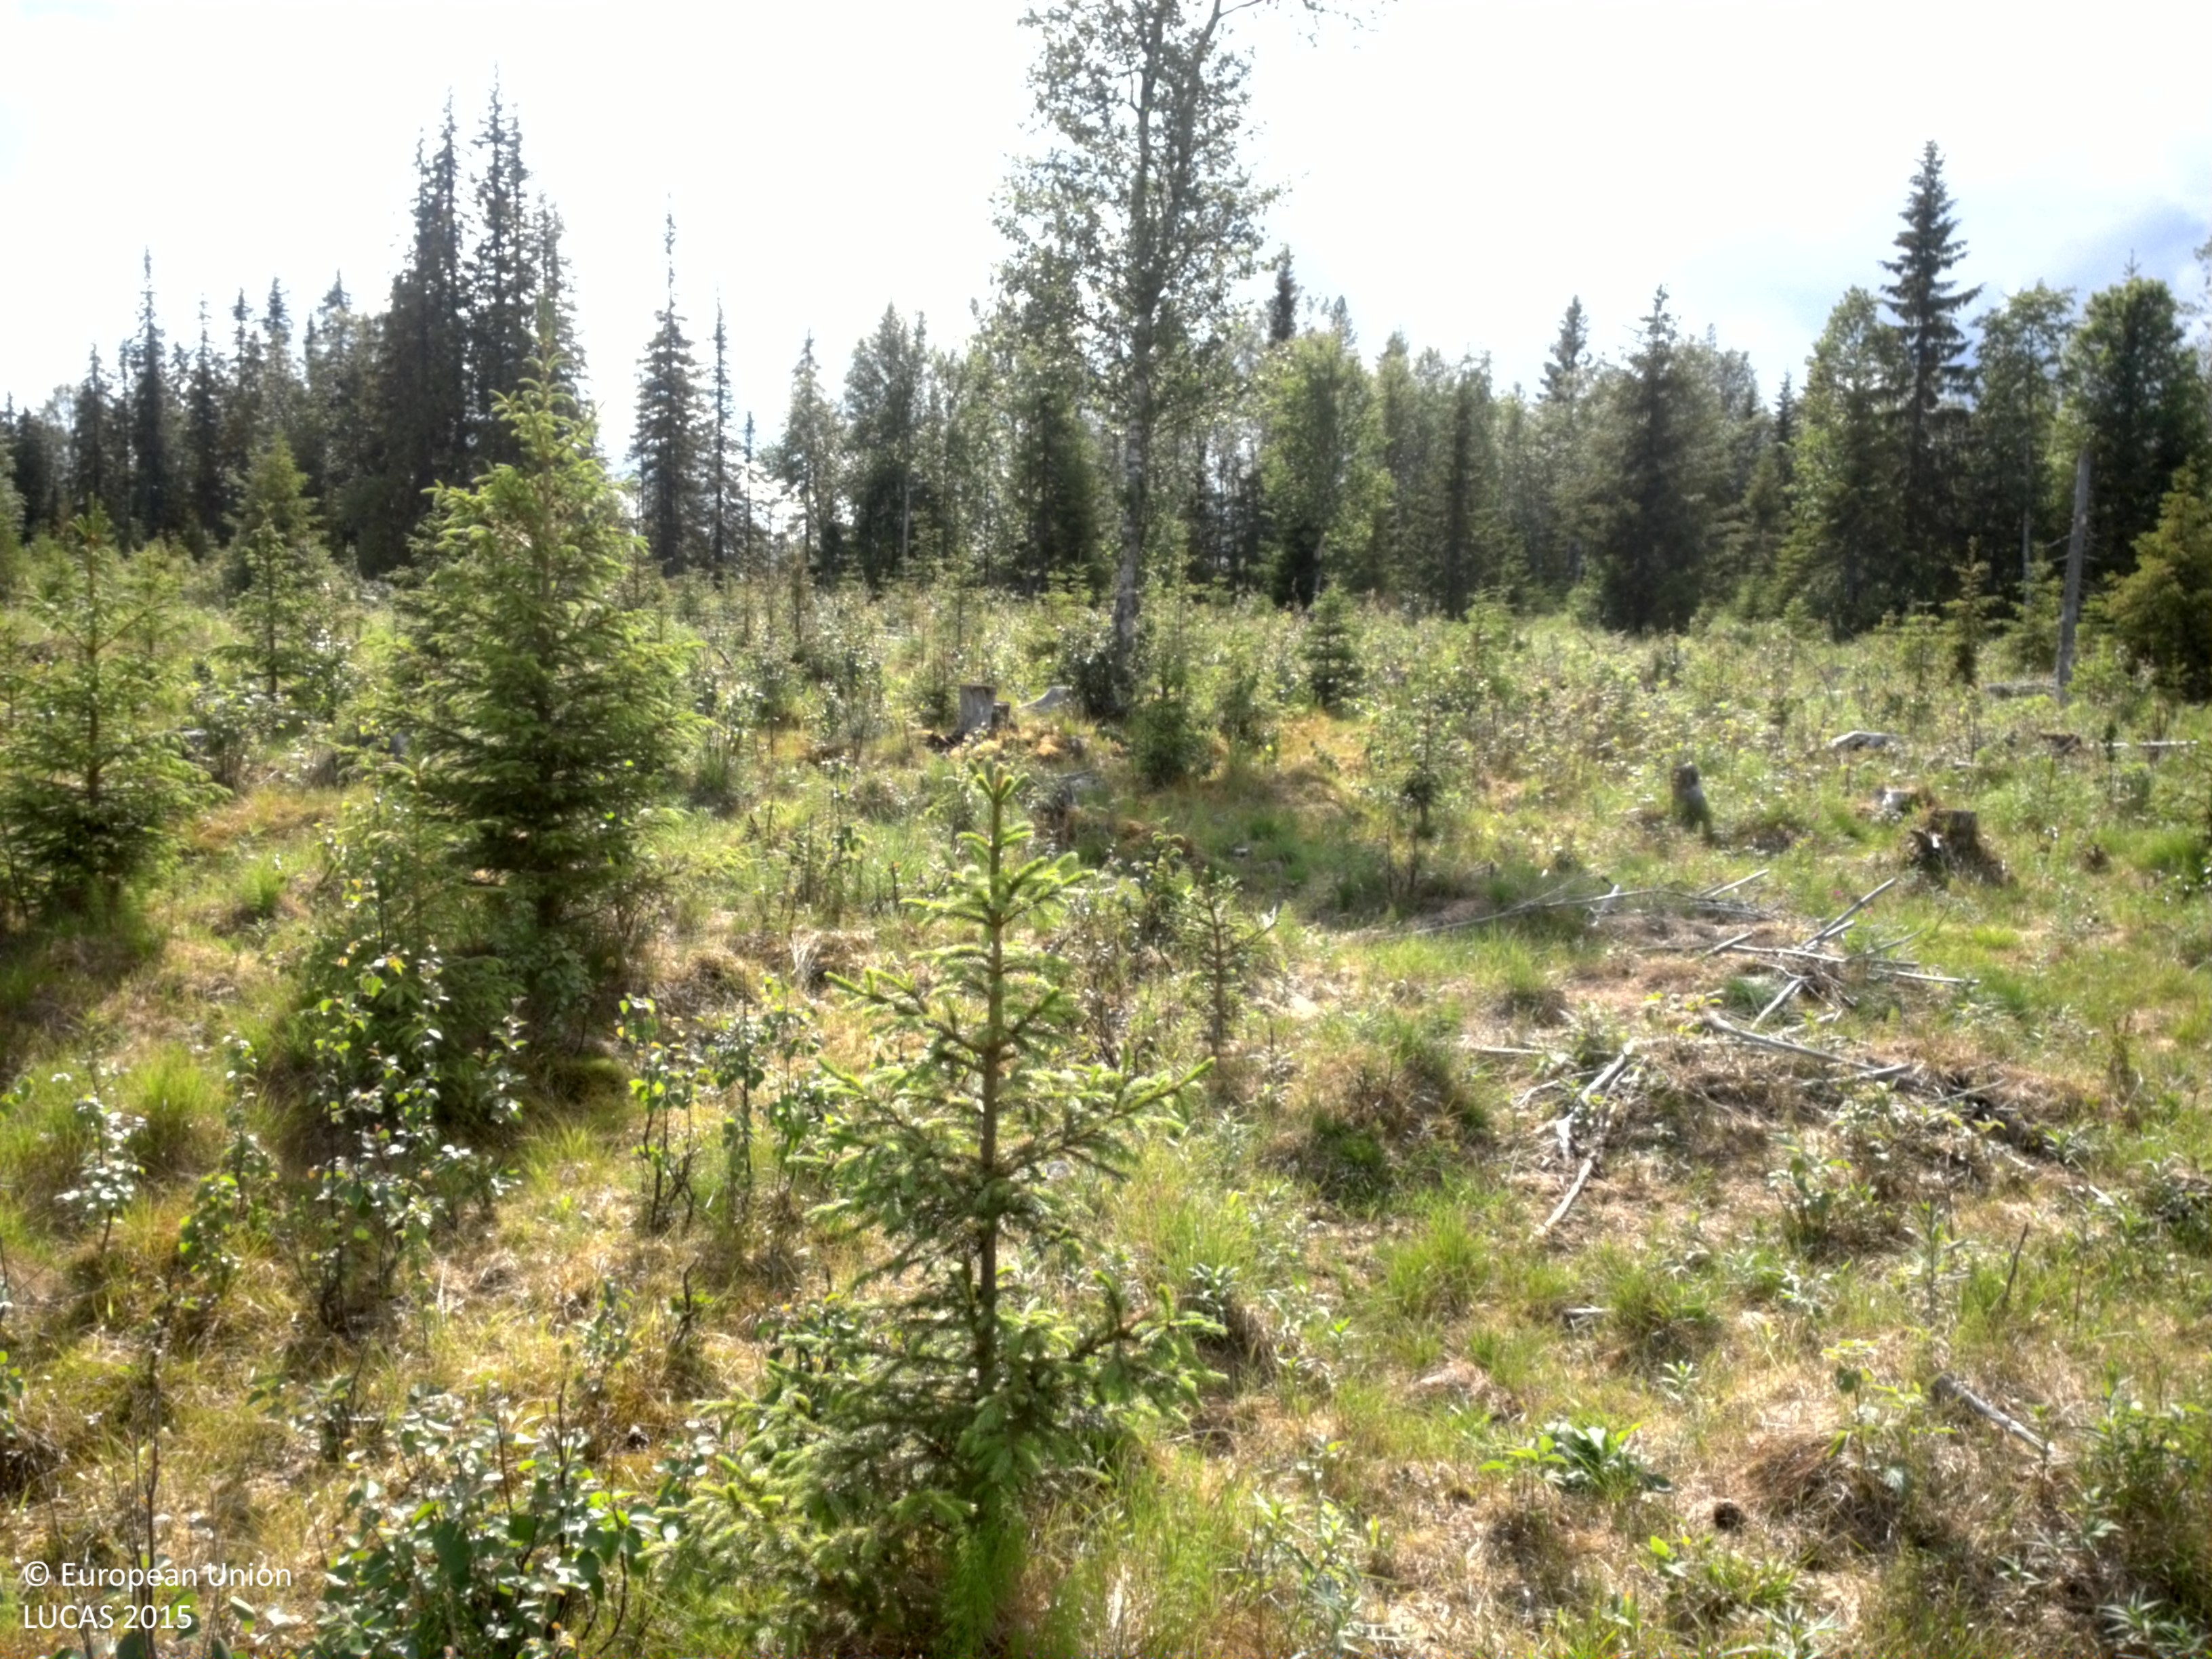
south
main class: Woodland
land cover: Spruce dominated mixed woodland
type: boreal forest
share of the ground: 50 - 75 %
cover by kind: coniferous forest trees 45 %, broadleaved forest trees 30 %, herbaceous plants 20 %, shrubs 5 %
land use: Forestry
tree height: < 5 m
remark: Clear cut
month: July
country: SE
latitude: 64.4796
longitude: 18.1435
